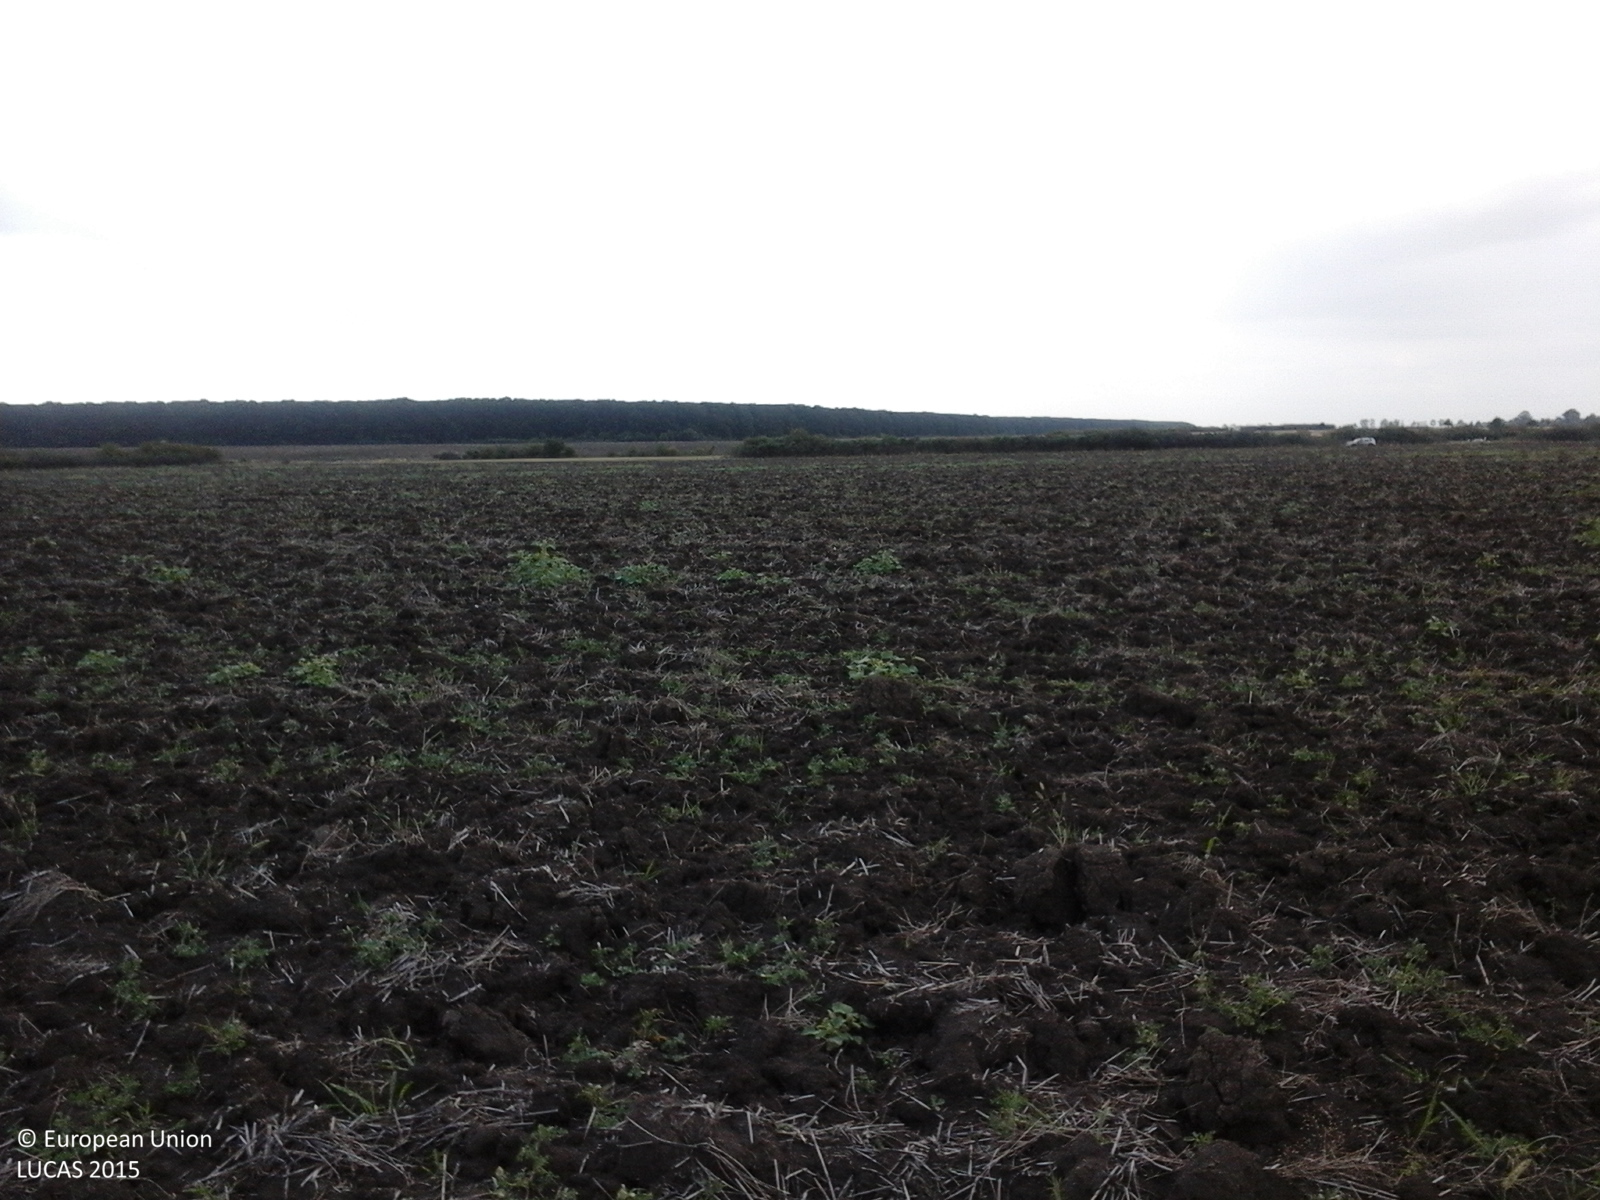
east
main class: Cropland
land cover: Common wheat
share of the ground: < 10 %
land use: Agriculture (excluding fallow land and kitchen gardens)
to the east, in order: Common wheat
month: August
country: RO
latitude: 45.6717
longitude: 21.5224
